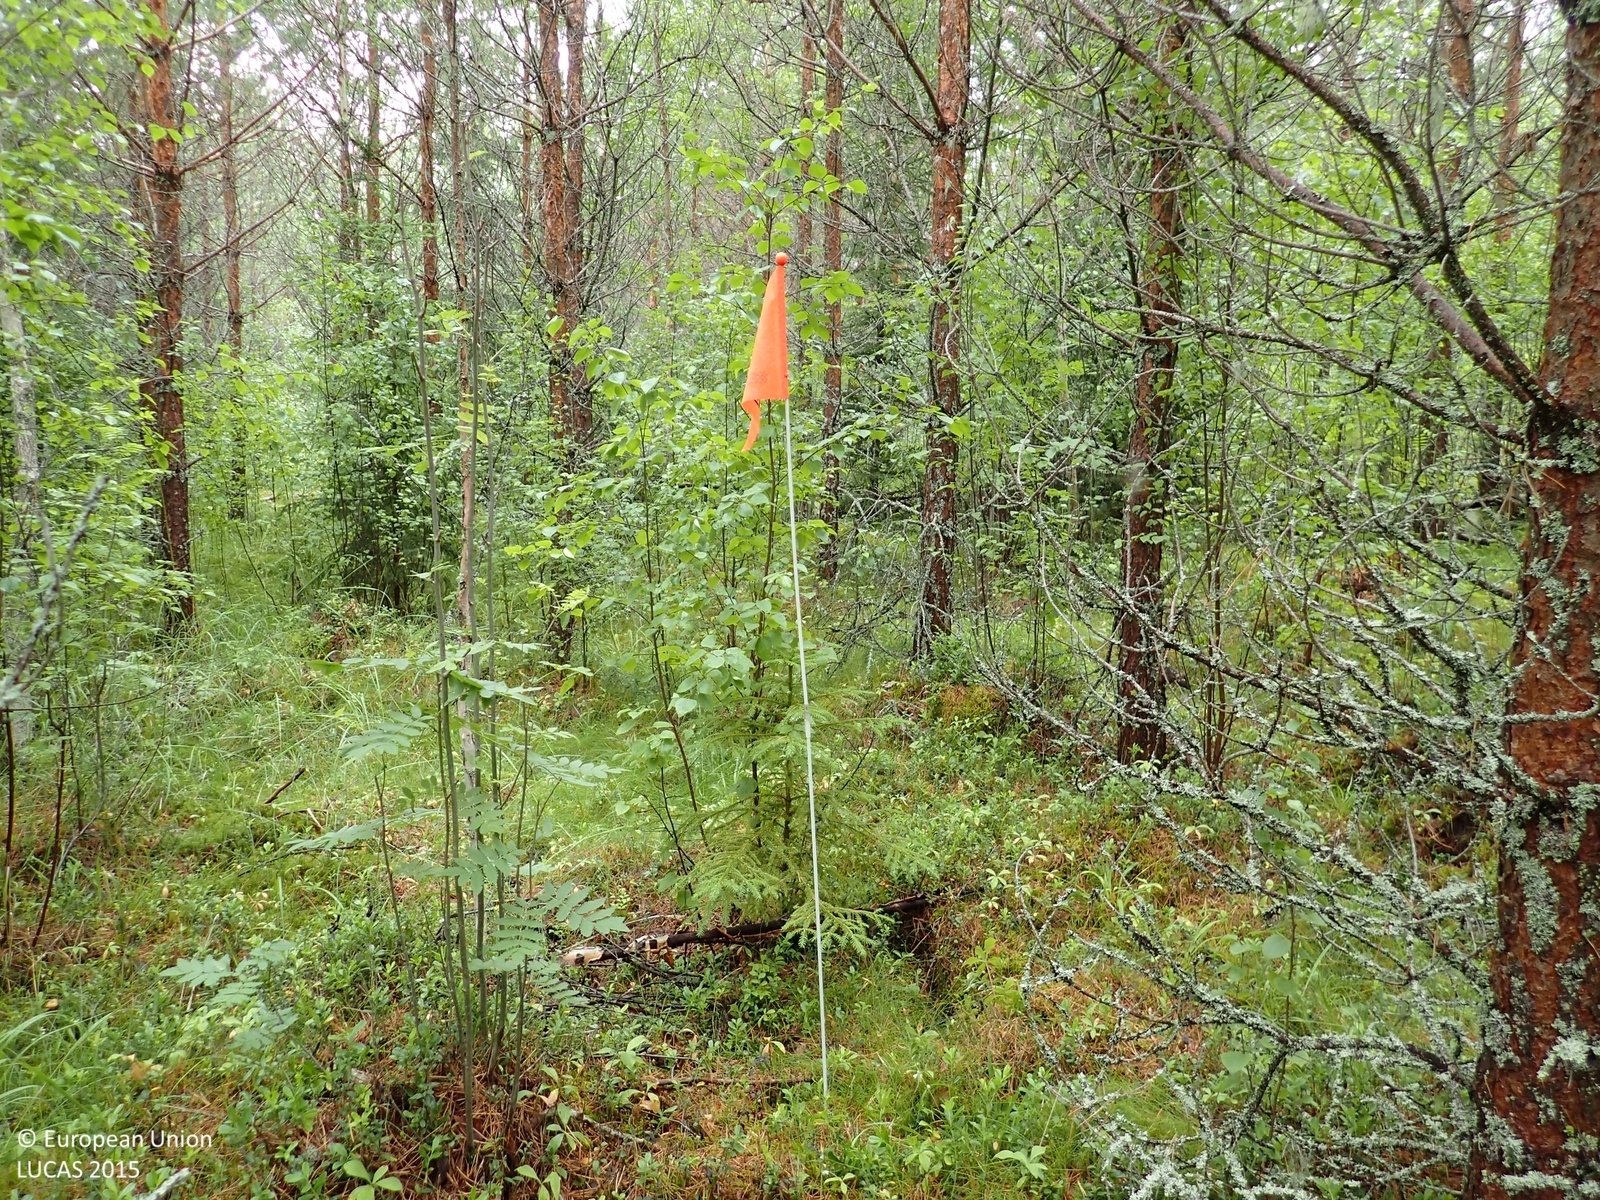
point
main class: Woodland
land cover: Pine dominated coniferous woodland
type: boreal forest
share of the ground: > 75 %
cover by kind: coniferous forest trees 70 %, broadleaved forest trees 10 %, shrubs 10 %, herbaceous plants 5 %, lichens and mosses 5 %
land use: Forestry
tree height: > 5 m
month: July
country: FI
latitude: 62.8967
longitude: 21.7890
